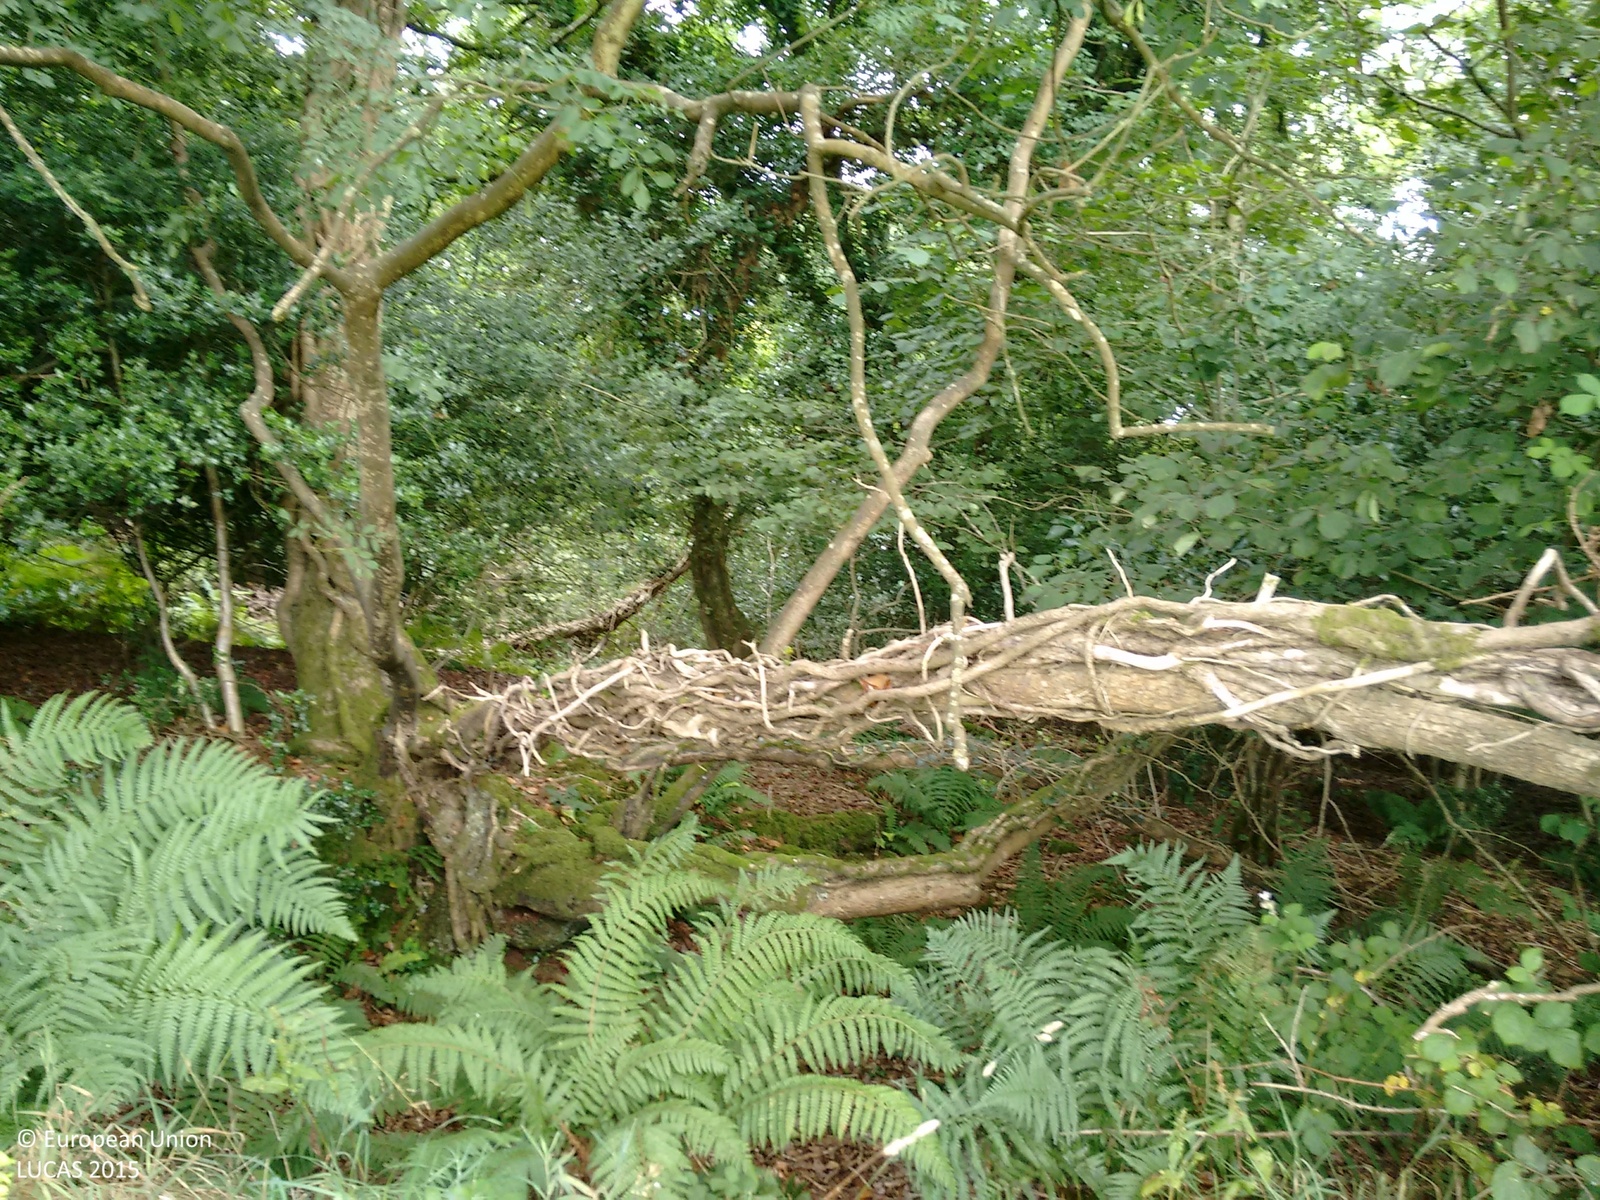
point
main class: Woodland
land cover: Broadleaved woodland
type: mesophytic deciduous forest
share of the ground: > 75 %
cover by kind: broadleaved forest trees 100 %
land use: Semi-natural and natural areas not in use
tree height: > 5 m
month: August
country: GB
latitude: 50.8739
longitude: -3.4849
